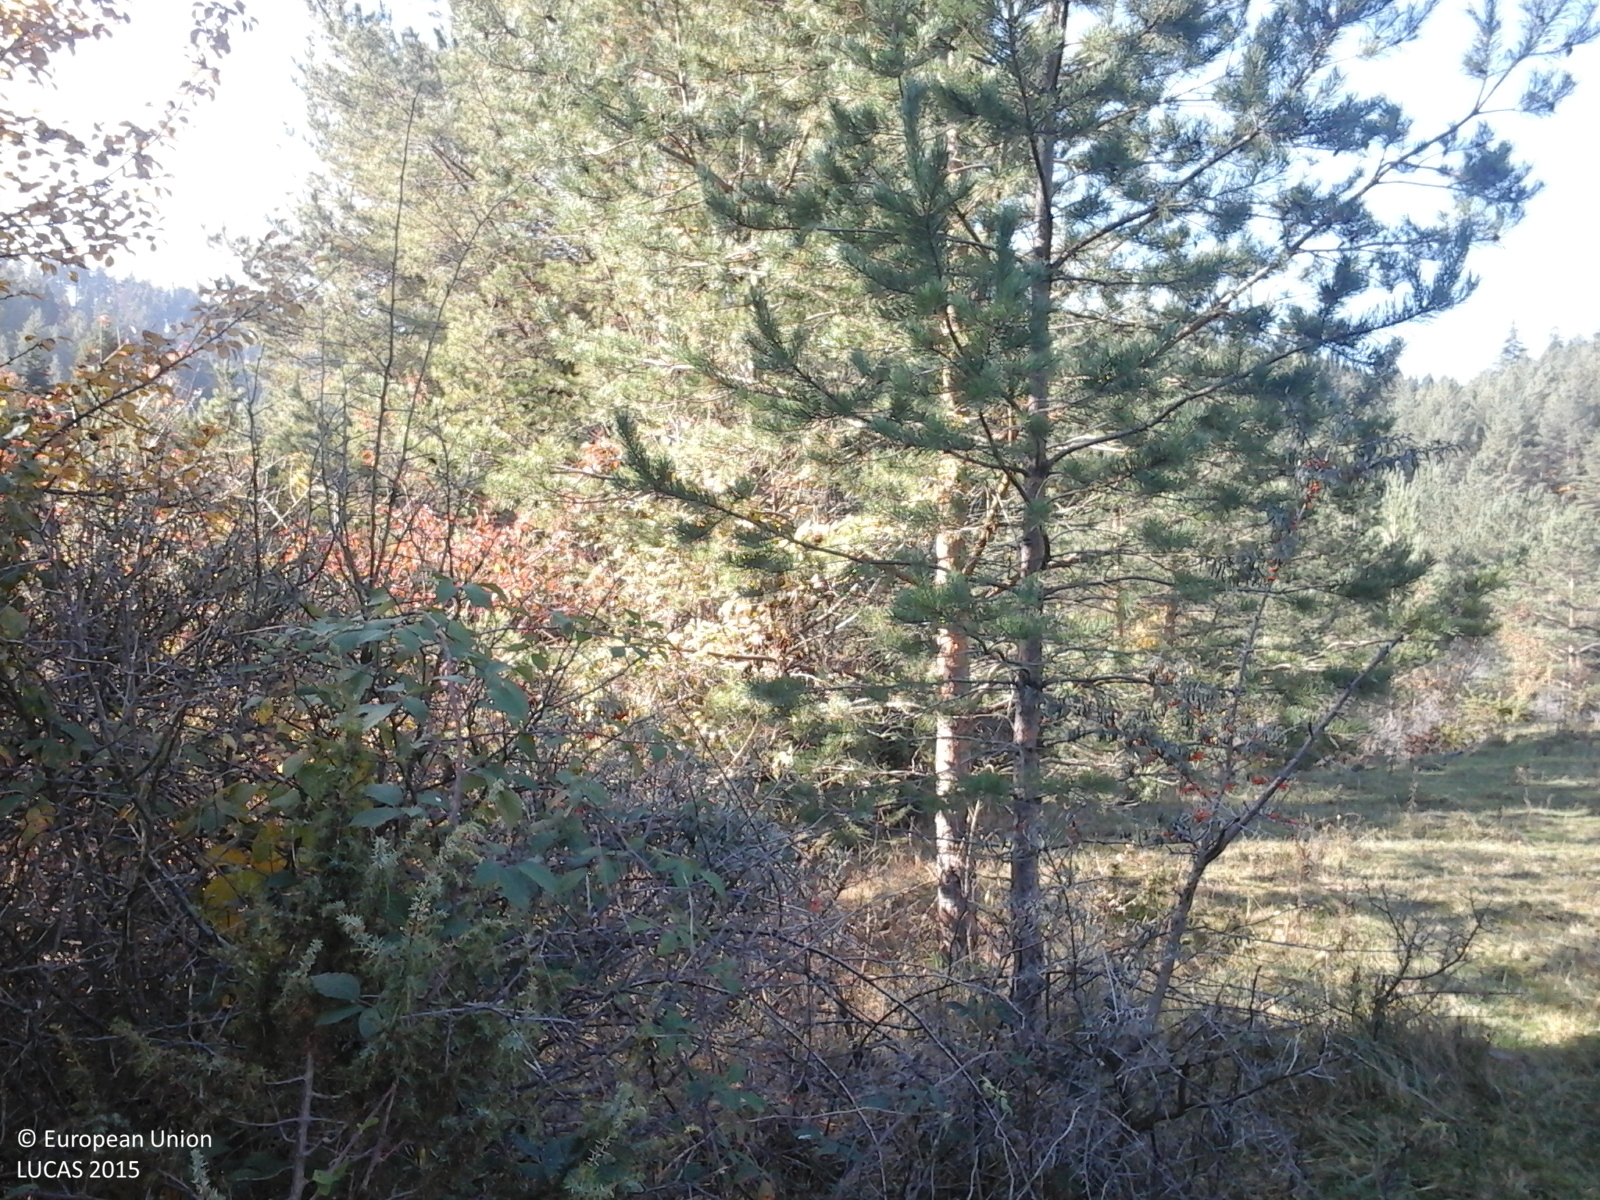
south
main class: Woodland
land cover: Pine dominated coniferous woodland
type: alpine coniferous forest
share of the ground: > 75 %
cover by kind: coniferous forest trees 100 %
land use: Forestry
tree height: > 5 m
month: October
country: RO
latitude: 45.9866
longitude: 26.6713
